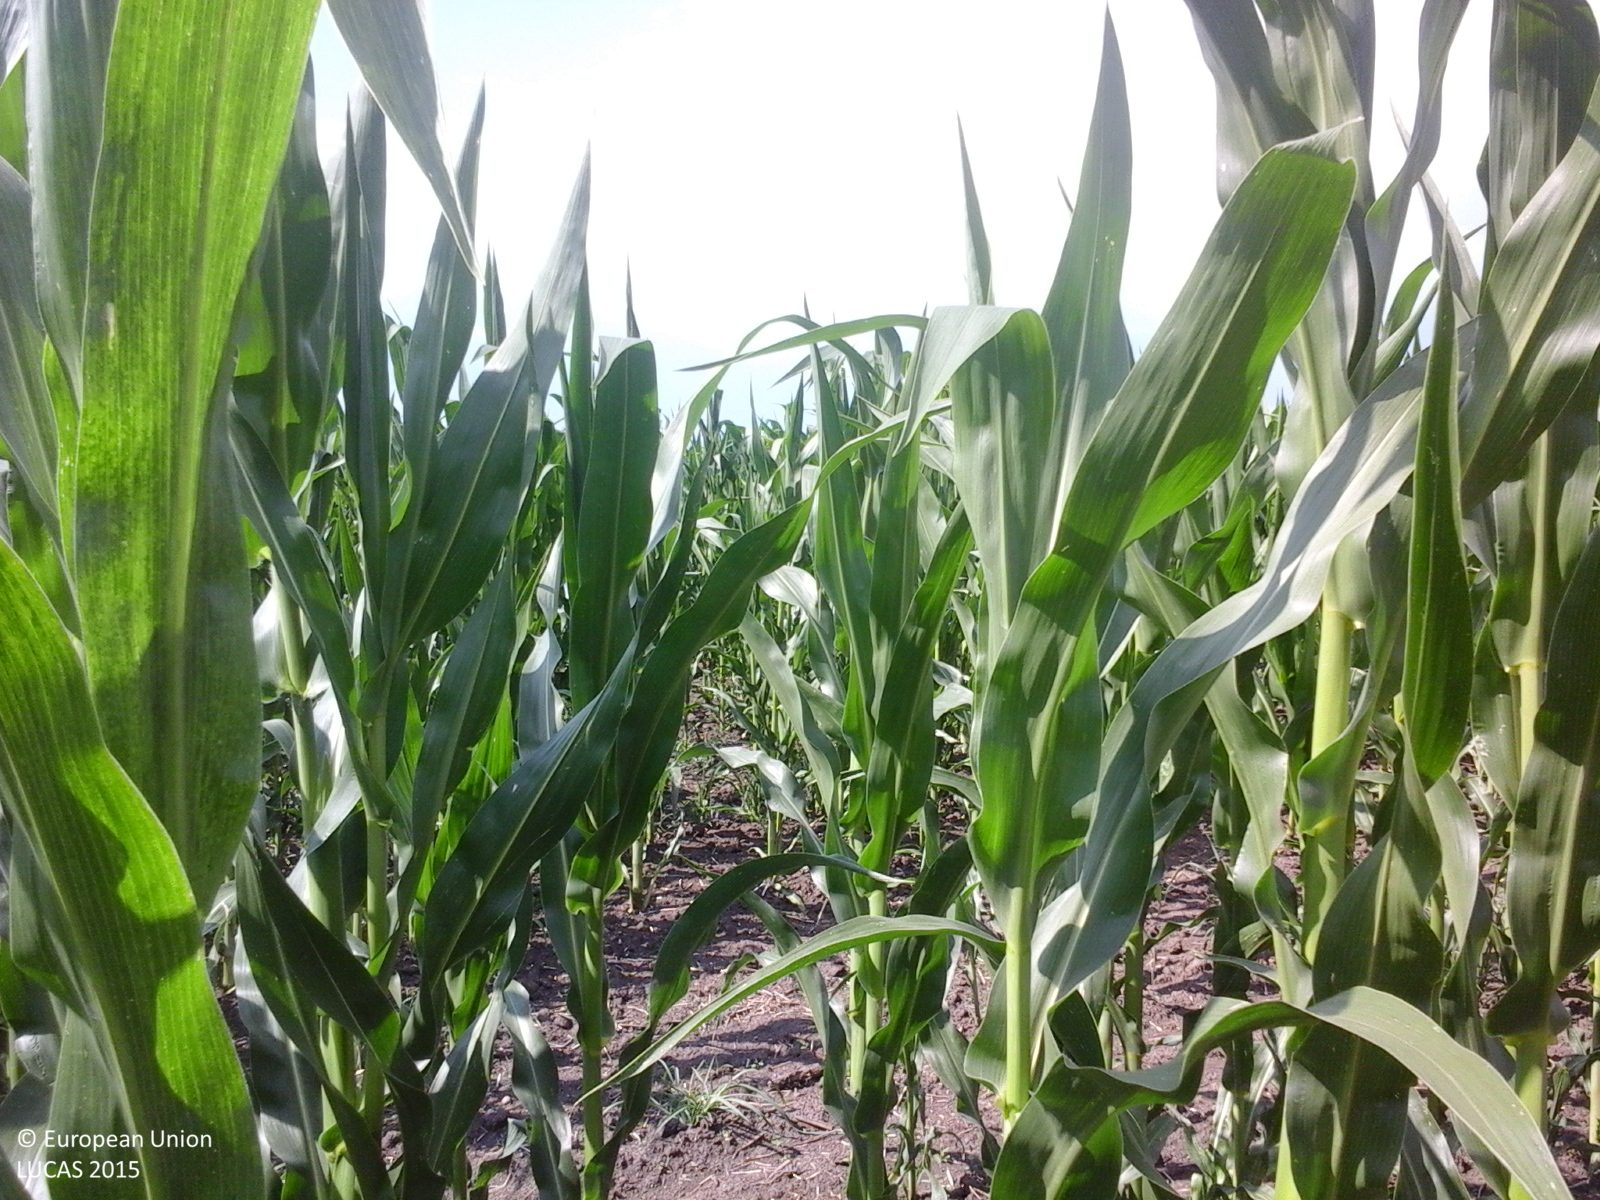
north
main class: Cropland
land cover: Maize
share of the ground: > 75 %
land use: Agriculture (excluding fallow land and kitchen gardens)
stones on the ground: < 10 %
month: July
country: RO
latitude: 44.3369
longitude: 25.3506
